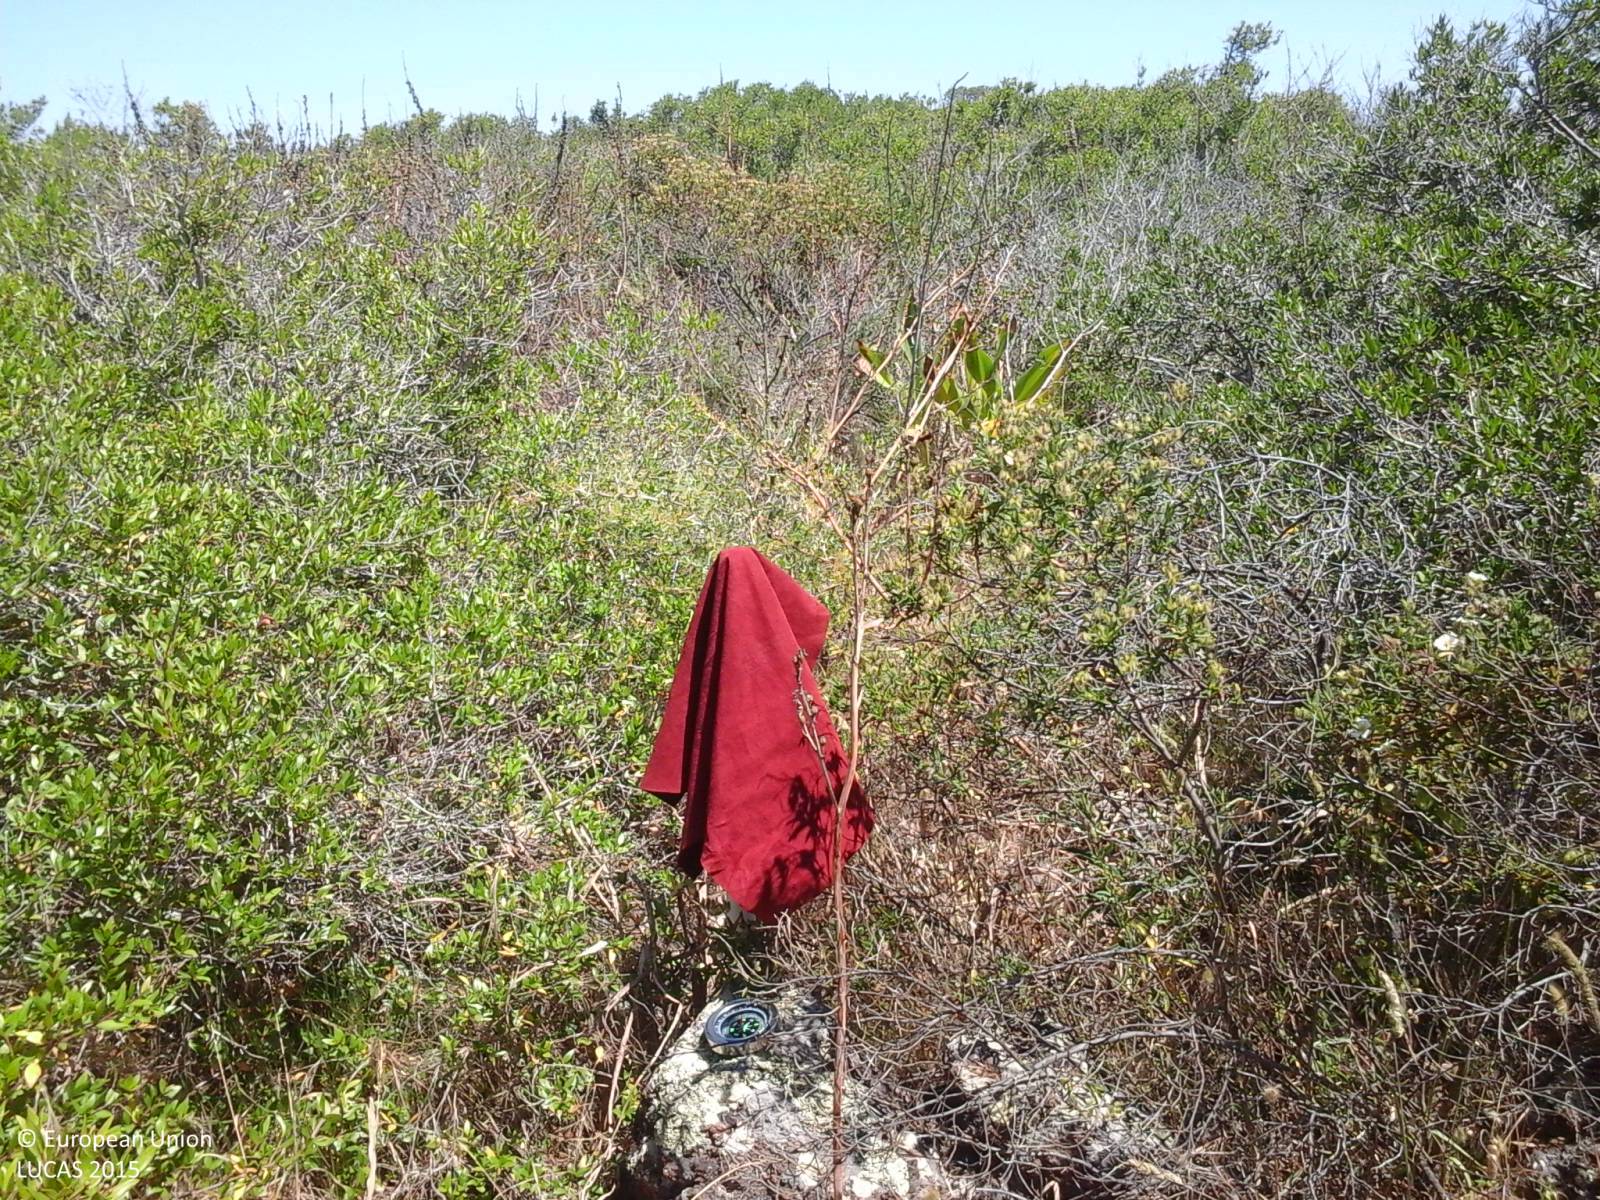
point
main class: Shrubland
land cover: Shrubland without tree cover
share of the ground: > 75 %
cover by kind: shrubs 80 %, herbaceous plants 20 %
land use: Semi-natural and natural areas not in use
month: May
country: IT
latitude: 40.6354
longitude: 8.4586
